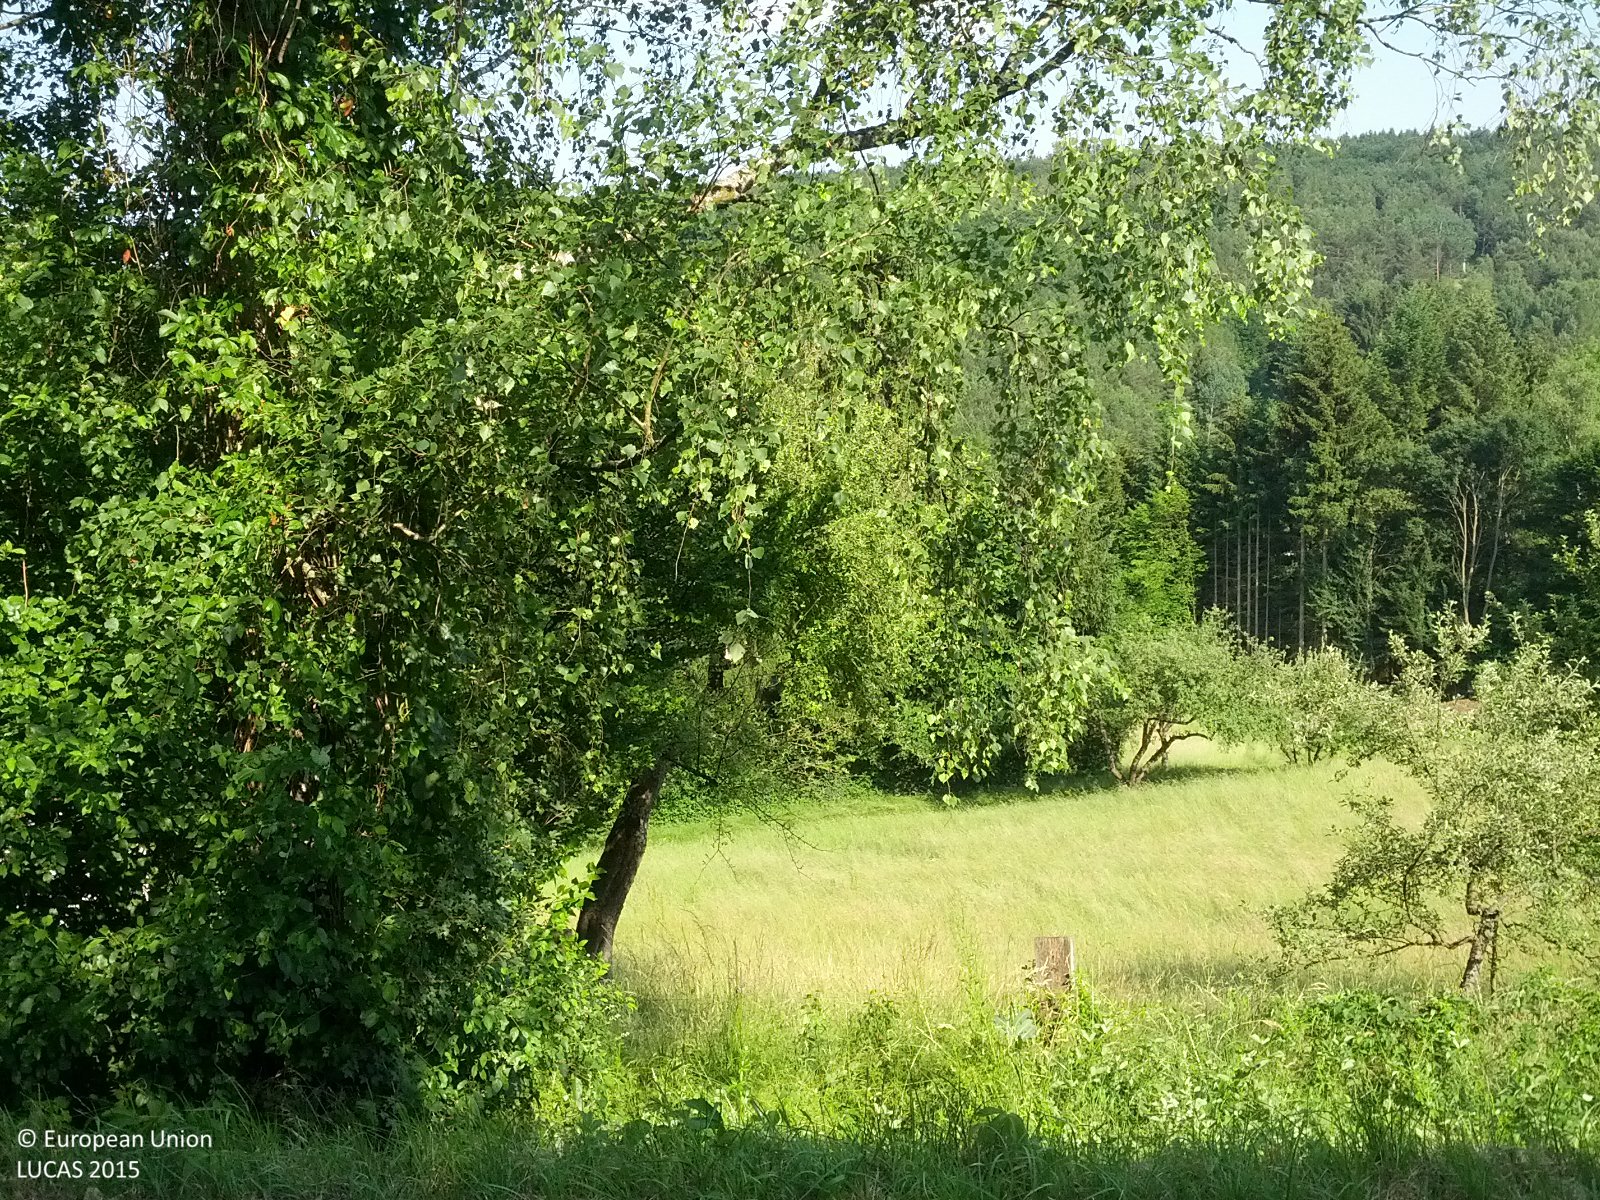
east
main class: Shrubland
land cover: Shrubland without tree cover
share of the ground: > 75 %
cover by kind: shrubs 70 %, herbaceous plants 20 %, lichens and mosses 10 %
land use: Abandoned areas
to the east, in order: Shrubland without tree cover; Paved roads, cycling and walking lanes; Grass margins; Broadleaved woodland; Fences; Grassland without tree/shrub cover; Fences; Single bushes/trees; Tracks; Spruce dominated mixed woodland; Artificial constructions in urban areas; Rivers and streams; Pine dominated mixed woodland
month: June
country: AT
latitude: 48.1811
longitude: 16.0967
